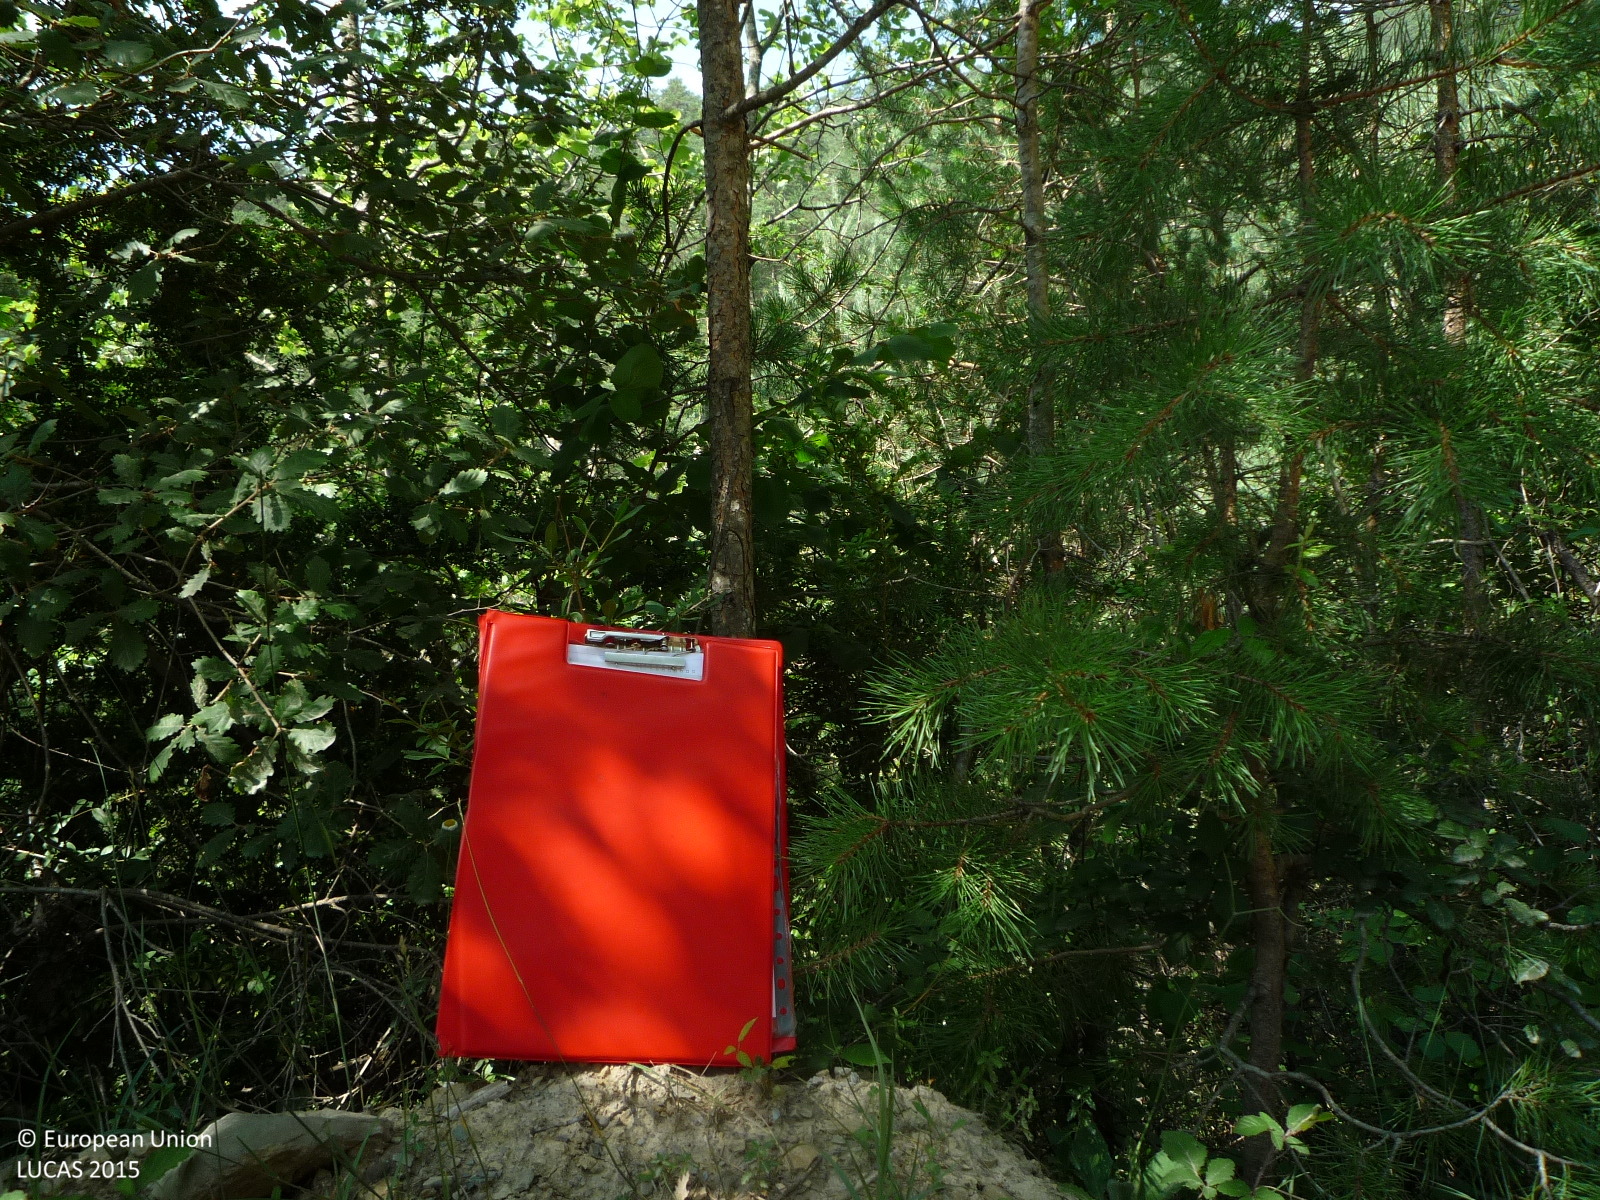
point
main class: Woodland
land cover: Pine dominated mixed woodland
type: coniferous forest of the mediterranean region
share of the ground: > 75 %
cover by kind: coniferous forest trees 55 %, broadleaved forest trees 45 %
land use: Semi-natural and natural areas not in use
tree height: > 5 m
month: July
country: ES
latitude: 42.1710
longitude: 1.9628
